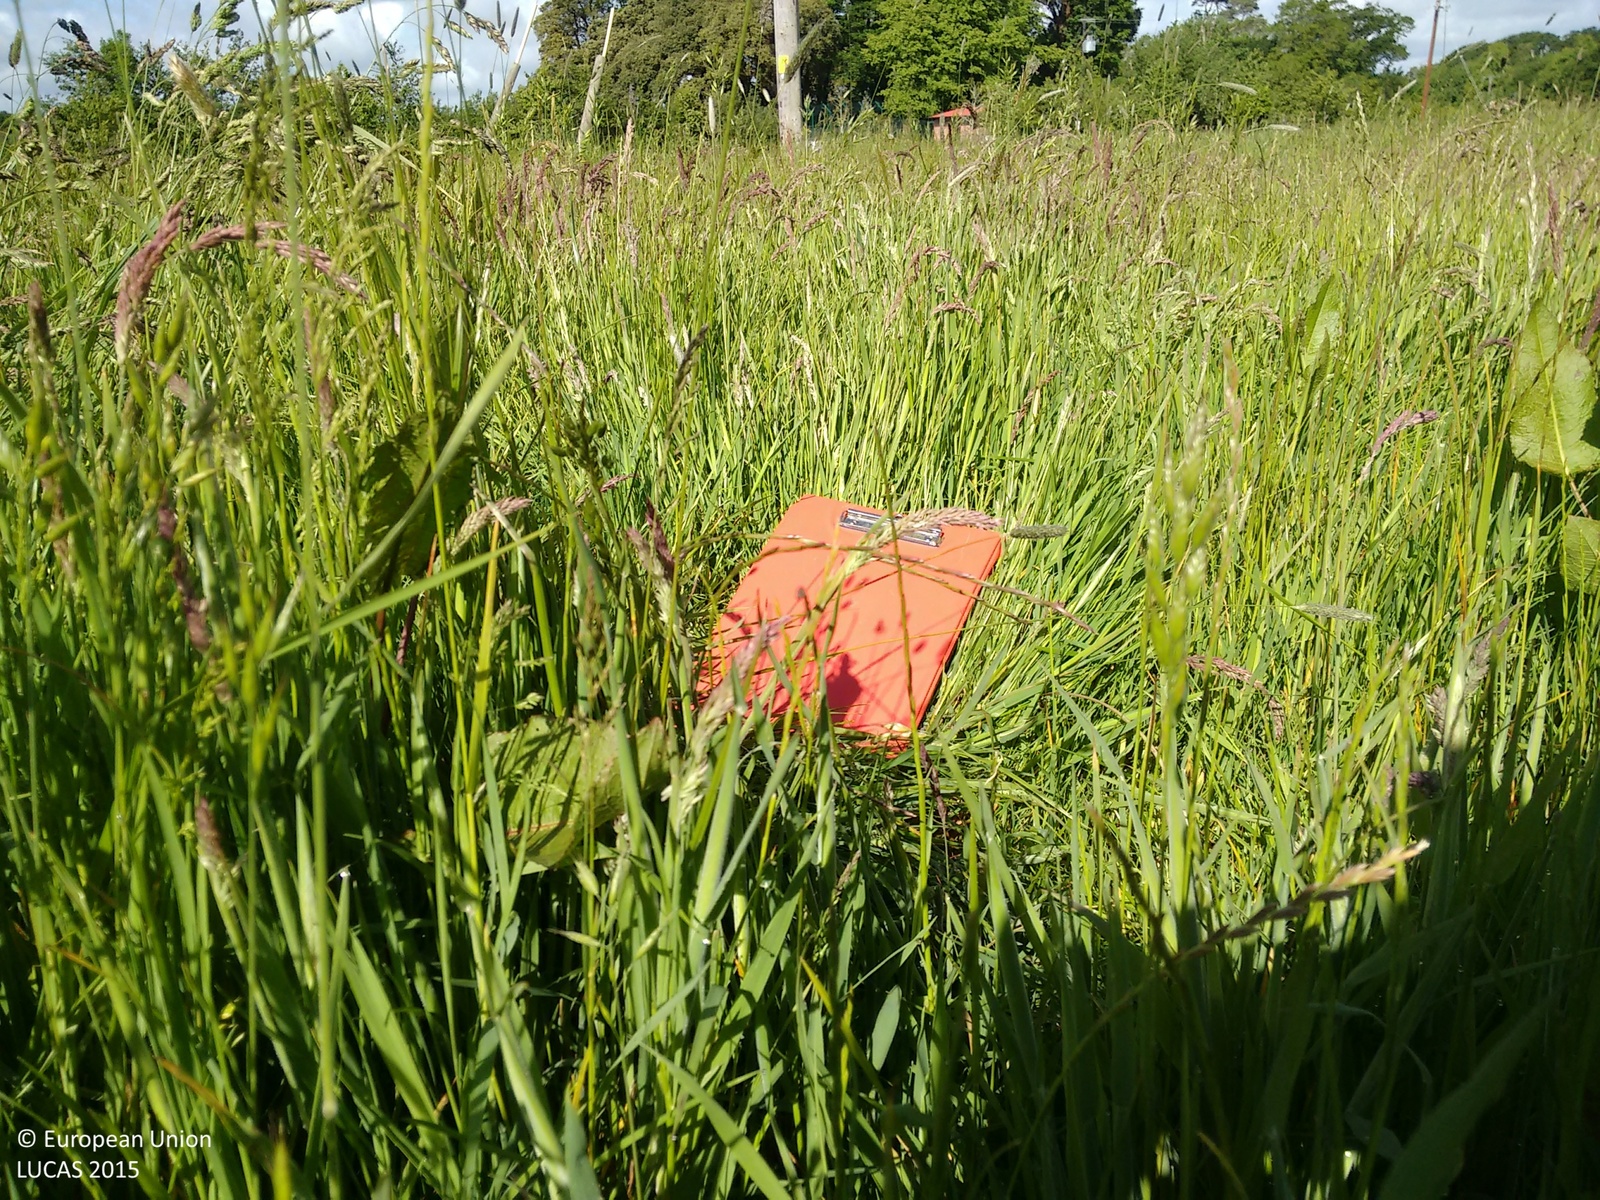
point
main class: Grassland
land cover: Grassland without tree/shrub cover
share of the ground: > 75 %
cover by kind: herbaceous plants 70 %, consolidated bare surface 30 %
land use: Agriculture (excluding fallow land and kitchen gardens)
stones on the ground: < 10 %
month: June
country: IE
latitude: 51.8954
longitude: -8.3083
